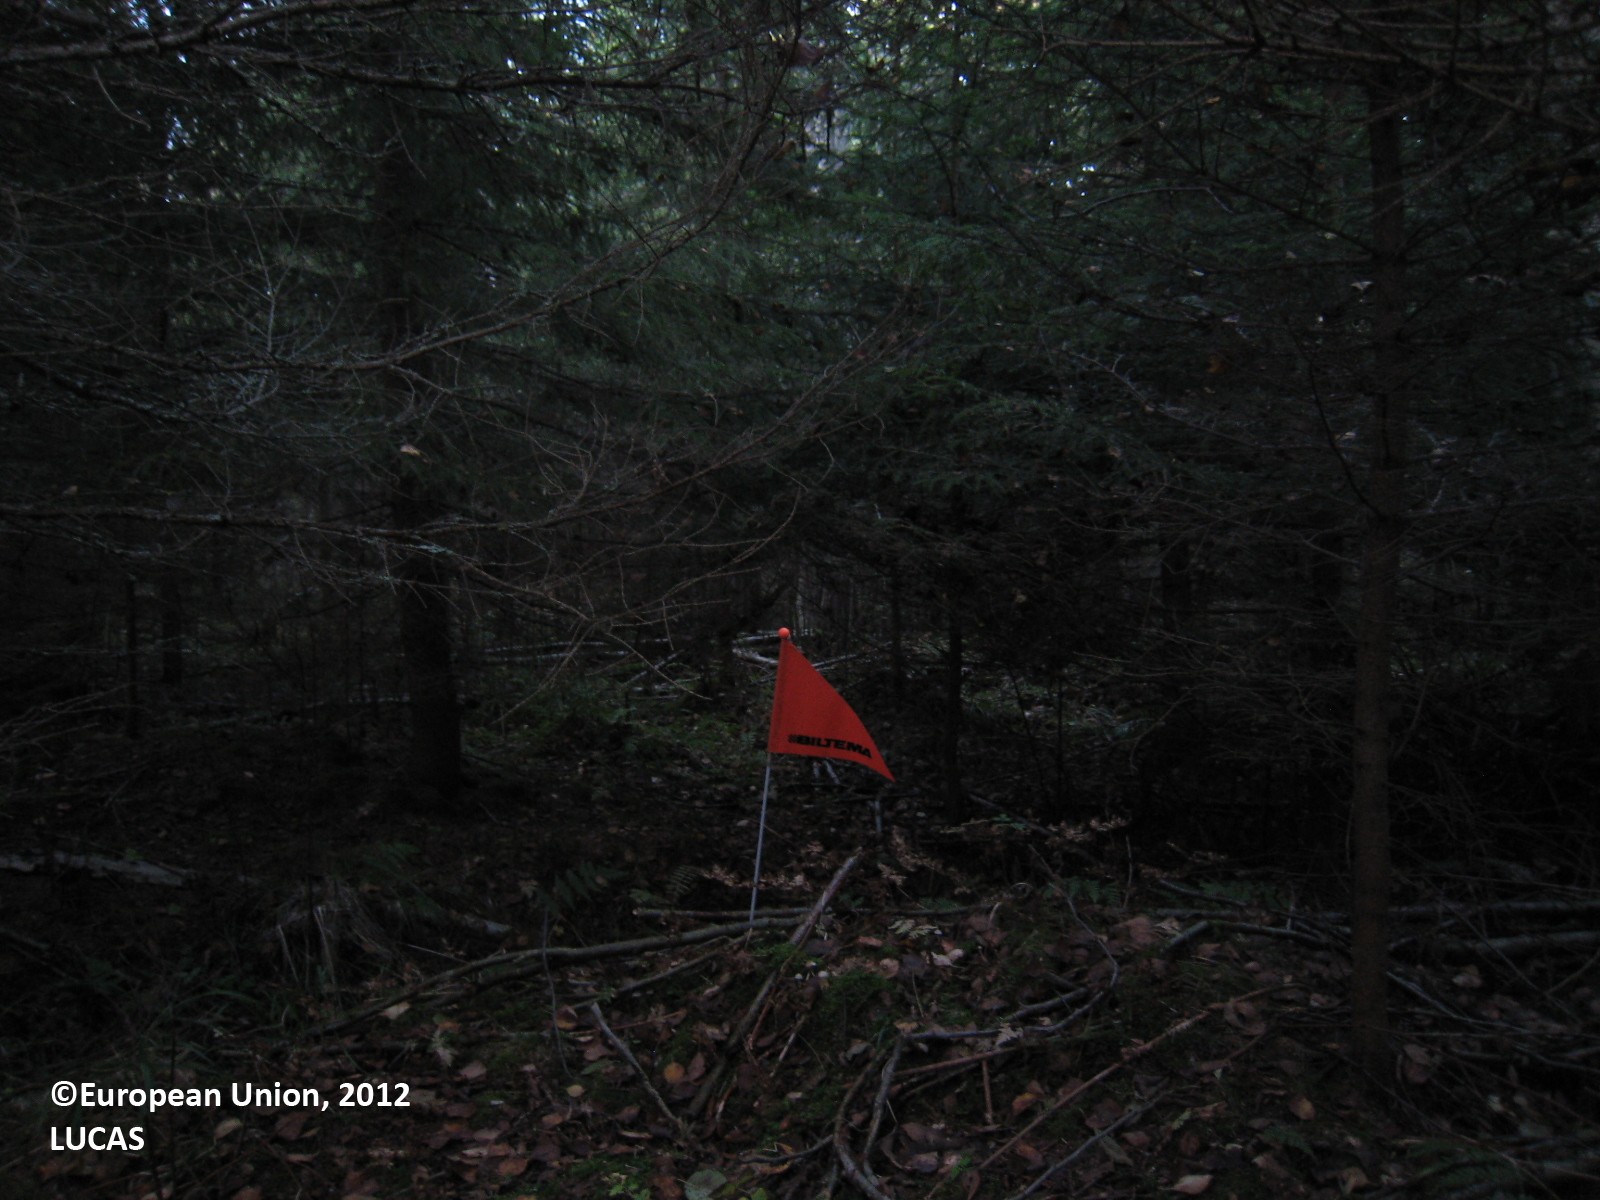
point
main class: Woodland
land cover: Spruce dominated mixed woodland
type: boreal forest
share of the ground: > 75 %
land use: Forestry
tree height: > 5 m
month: September
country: FI
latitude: 62.7972
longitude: 26.5475
